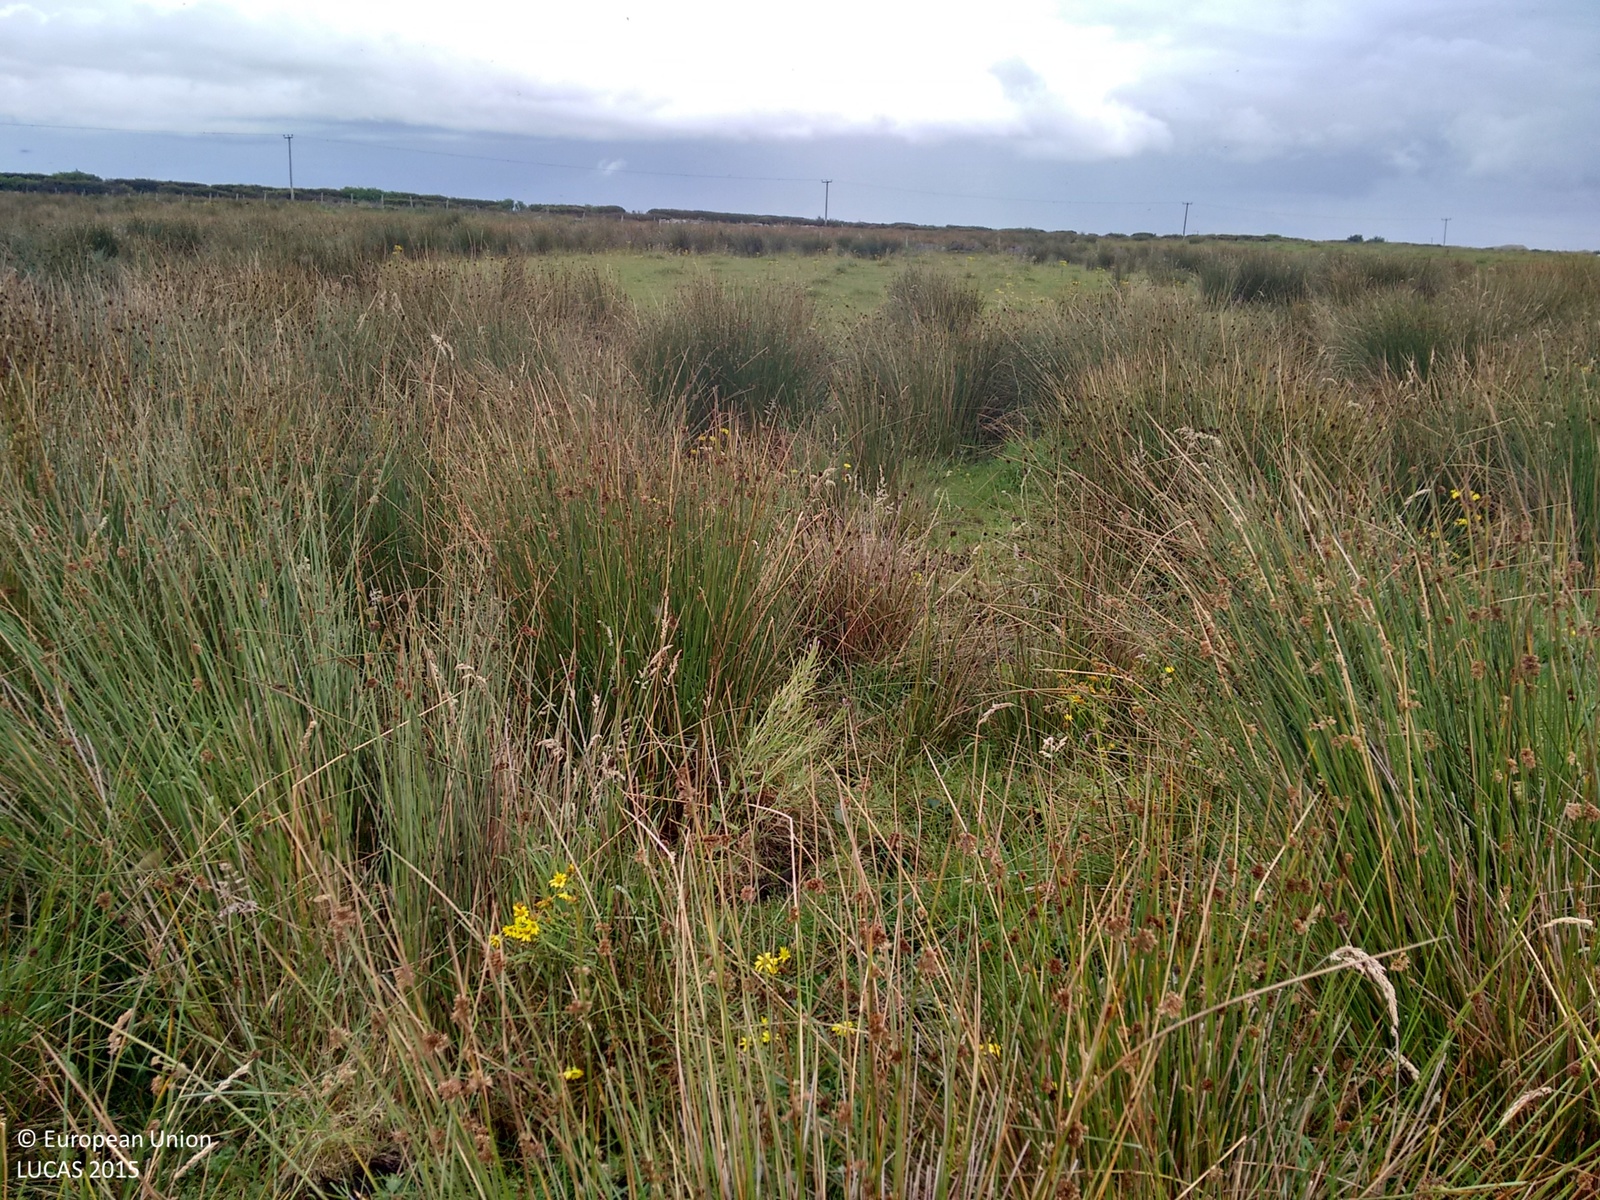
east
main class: Grassland
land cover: Grassland without tree/shrub cover
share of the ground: > 75 %
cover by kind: herbaceous plants 100 %
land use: Agriculture (excluding fallow land and kitchen gardens)
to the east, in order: Grassland without tree/shrub cover; Fences; Grassland without tree/shrub cover; Fences; Abandoned hedges; Electric lines; Ditches and canals; Grass margins; Paved roads, cycling and walking lanes; Grass margins; Ditches and canals; Abandoned hedges; Fences; Grassland without tree/shrub cover
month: August
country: GB
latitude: 58.5188
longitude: -3.1577
